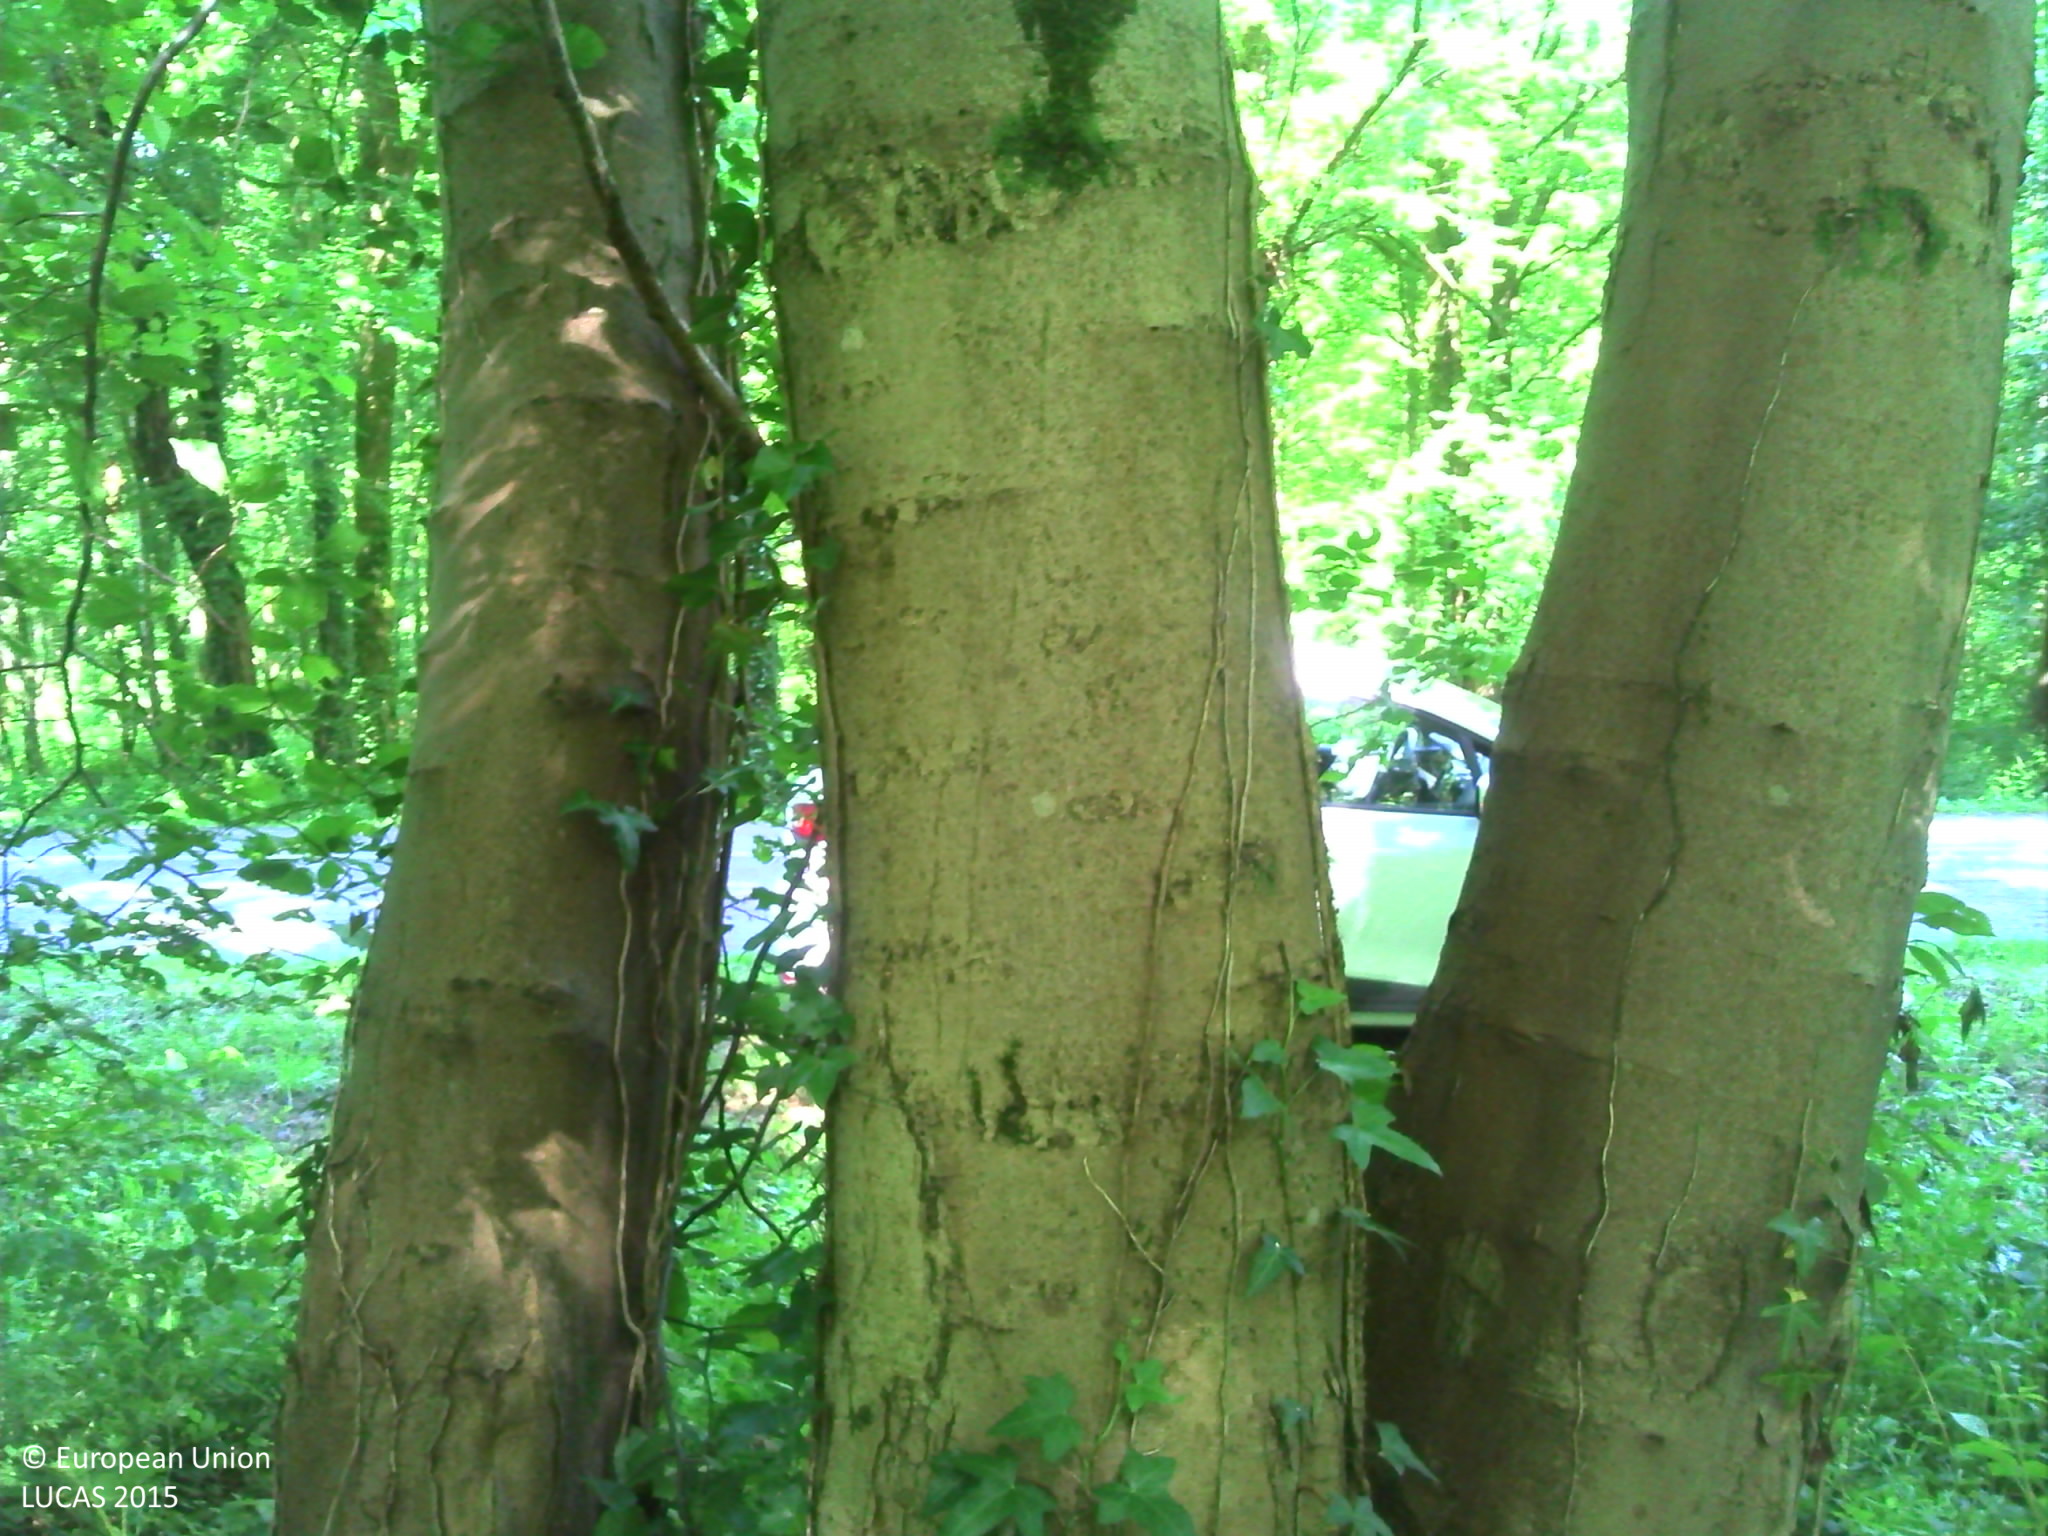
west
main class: Woodland
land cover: Broadleaved woodland
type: mesophytic deciduous forest
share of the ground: > 75 %
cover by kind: broadleaved forest trees 80 %, shrubs 10 %, herbaceous plants 10 %
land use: Forestry
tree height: > 5 m
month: June
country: FR
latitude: 49.9399
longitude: 4.0729
